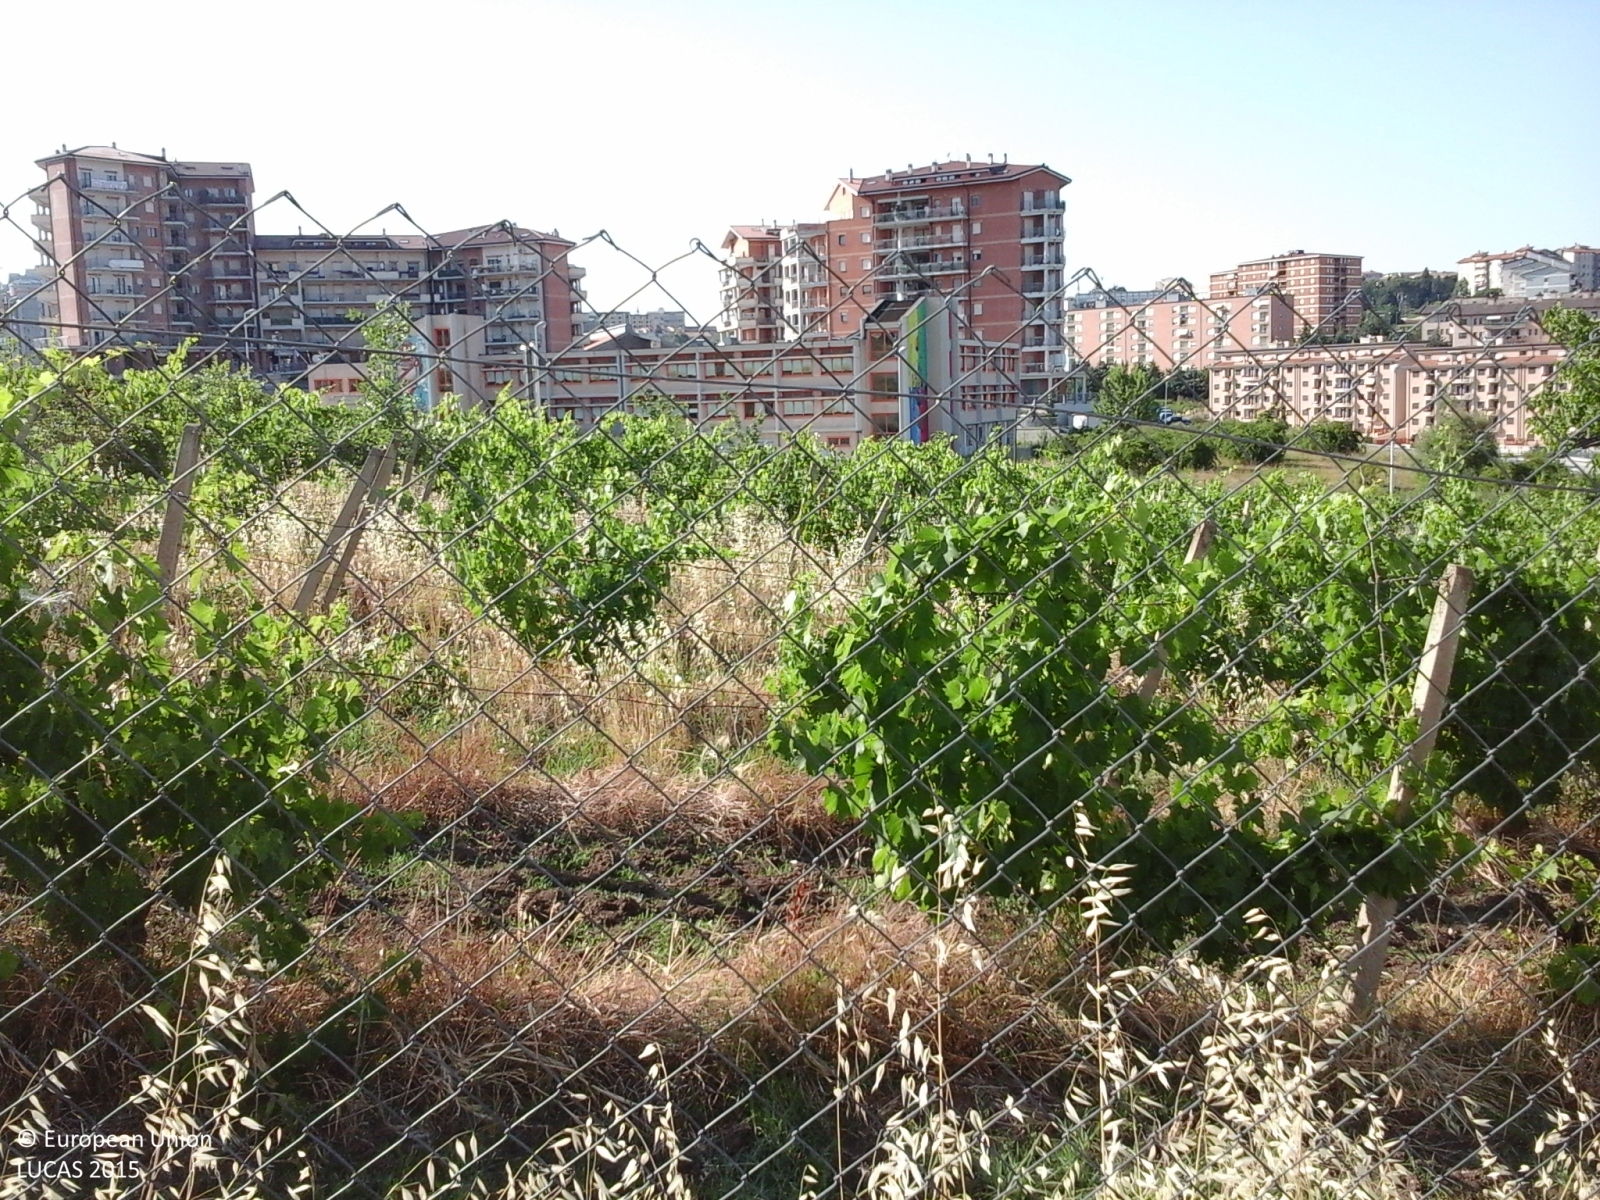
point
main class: Cropland
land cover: Vineyards
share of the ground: 50 - 75 %
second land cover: Spontaneously vegetated surfaces
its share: > 75 %
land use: Agriculture (excluding fallow land and kitchen gardens)
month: July
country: IT
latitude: 41.5510
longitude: 14.6714
